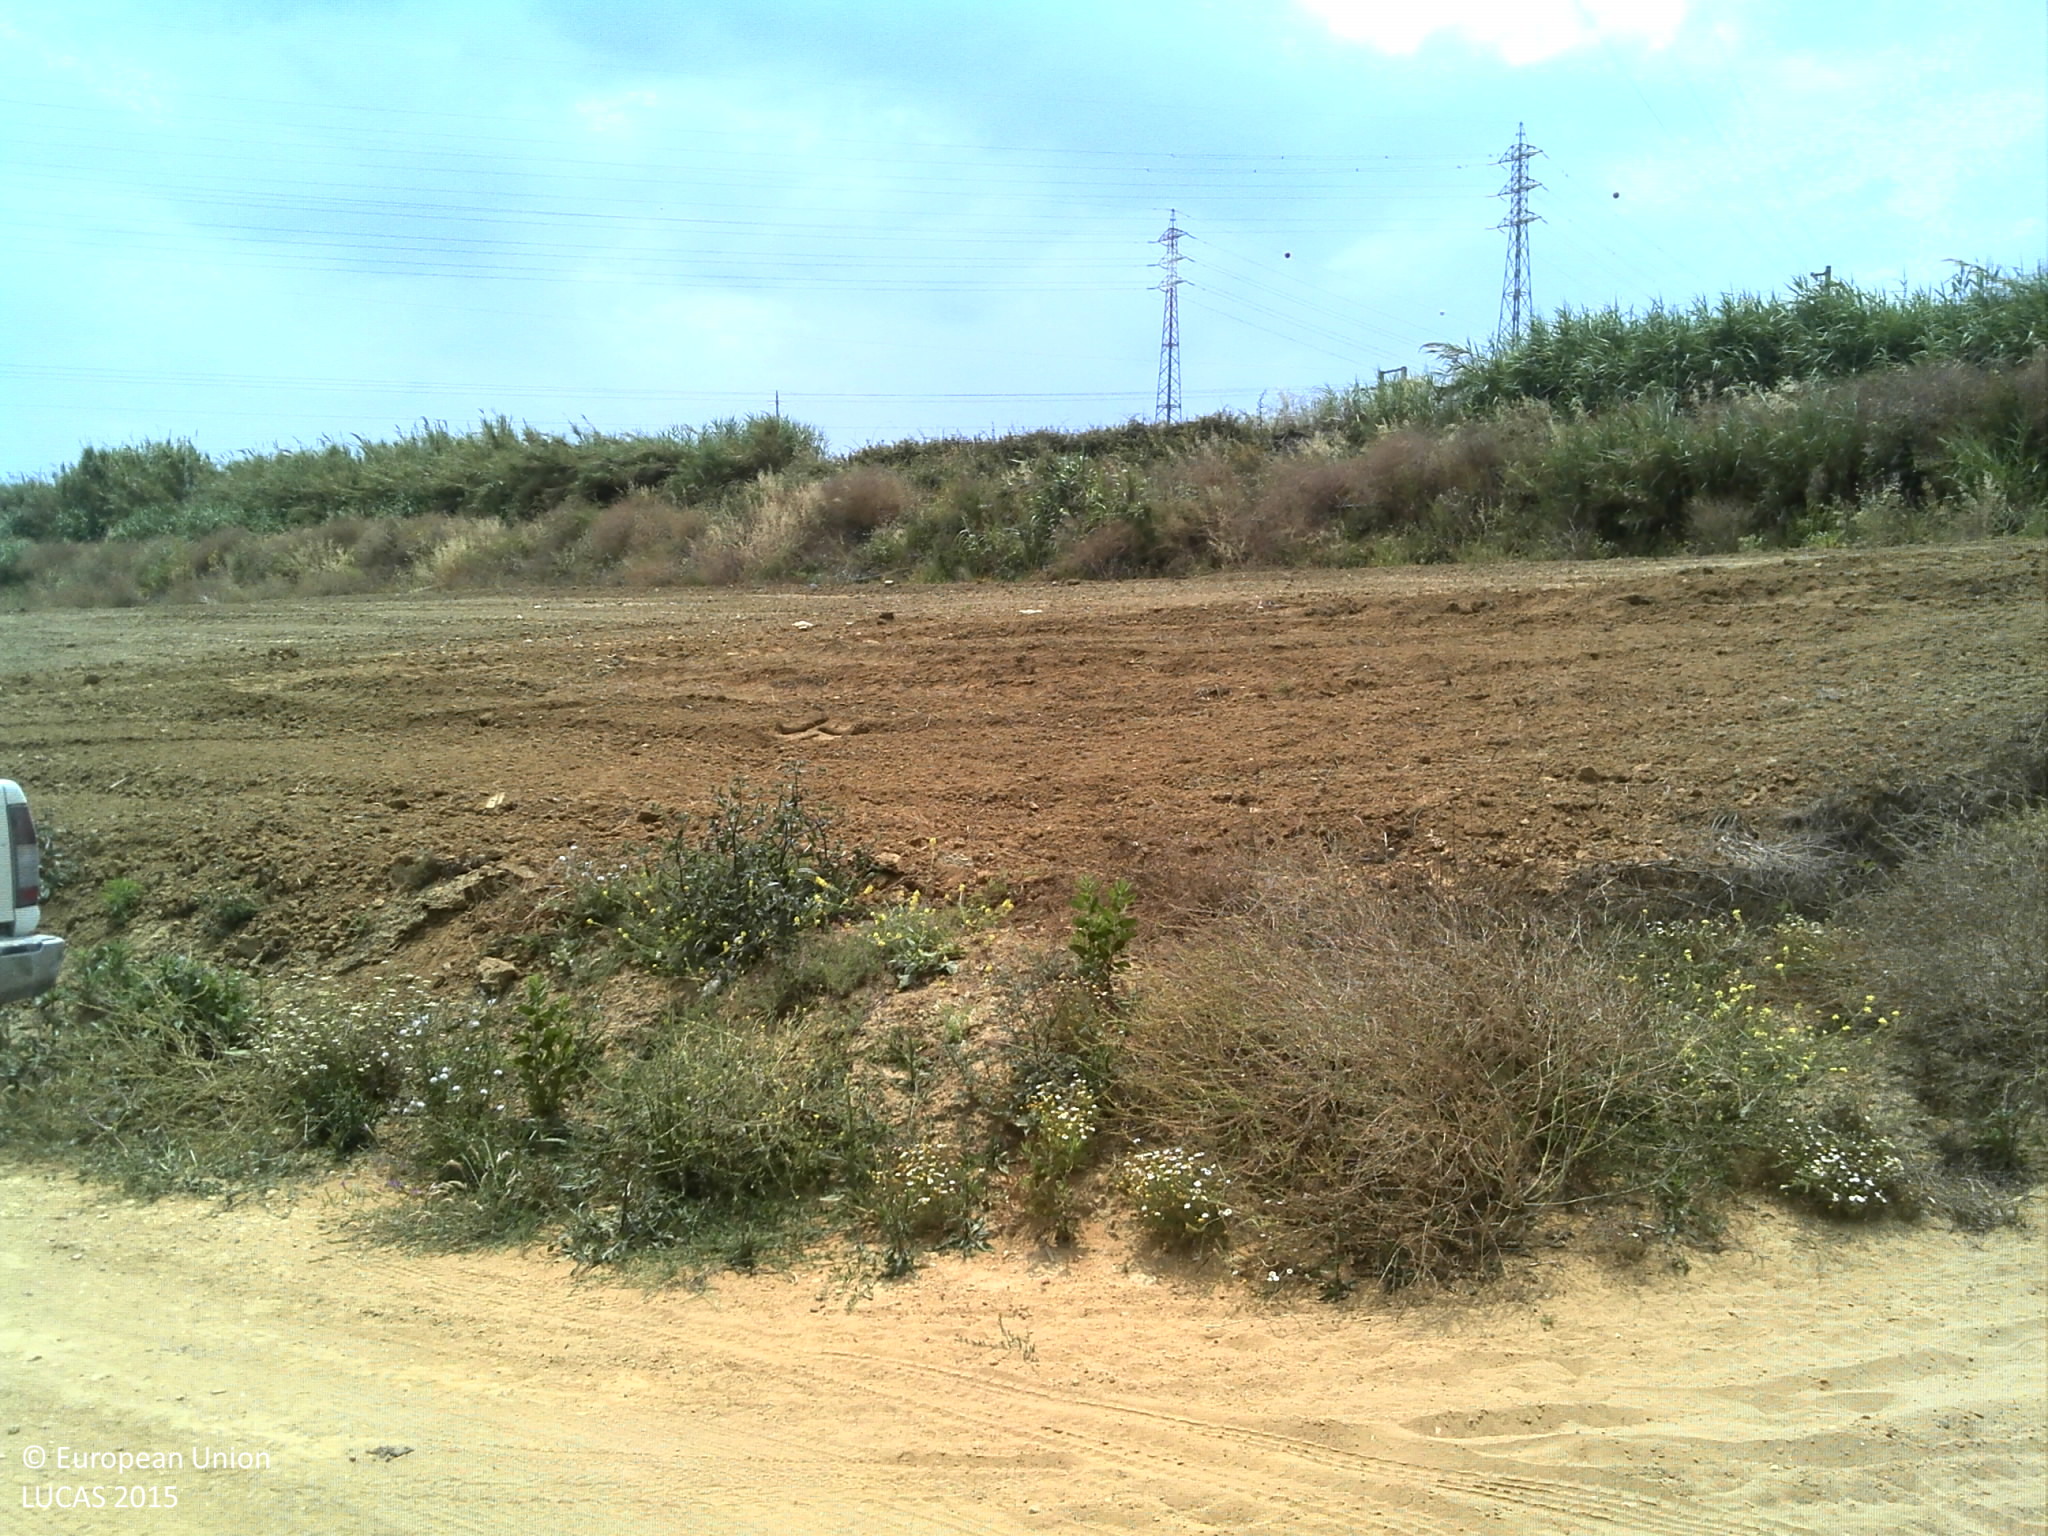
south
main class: Shrubland
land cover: Shrubland without tree cover
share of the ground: > 75 %
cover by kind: shrubs 60 %, unconsolidated bare surface 30 %, herbaceous plants 10 %
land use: Semi-natural and natural areas not in use
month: June
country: PT
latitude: 39.3284
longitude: -9.3148
